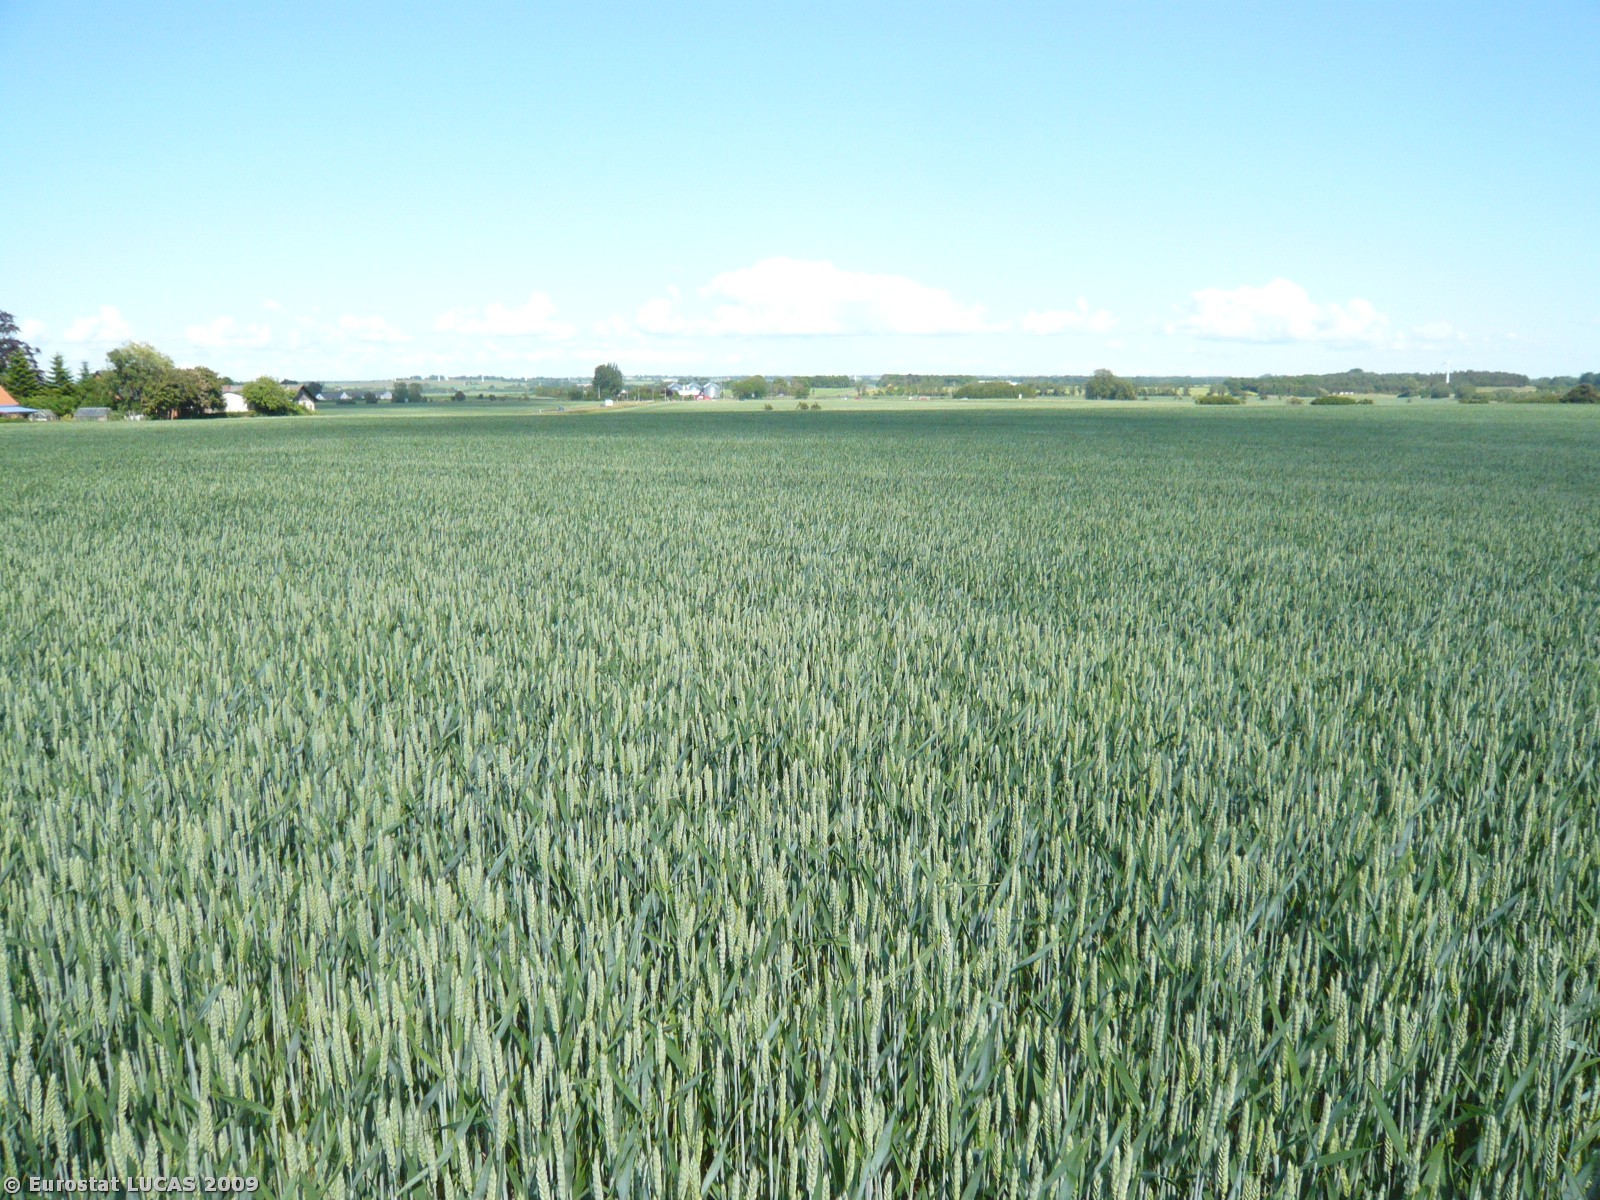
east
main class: Cropland
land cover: Common wheat
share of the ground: > 75 %
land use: Agriculture (excluding fallow land and kitchen gardens)
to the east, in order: Common wheat
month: June
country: DK
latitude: 55.3006
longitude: 11.2748
